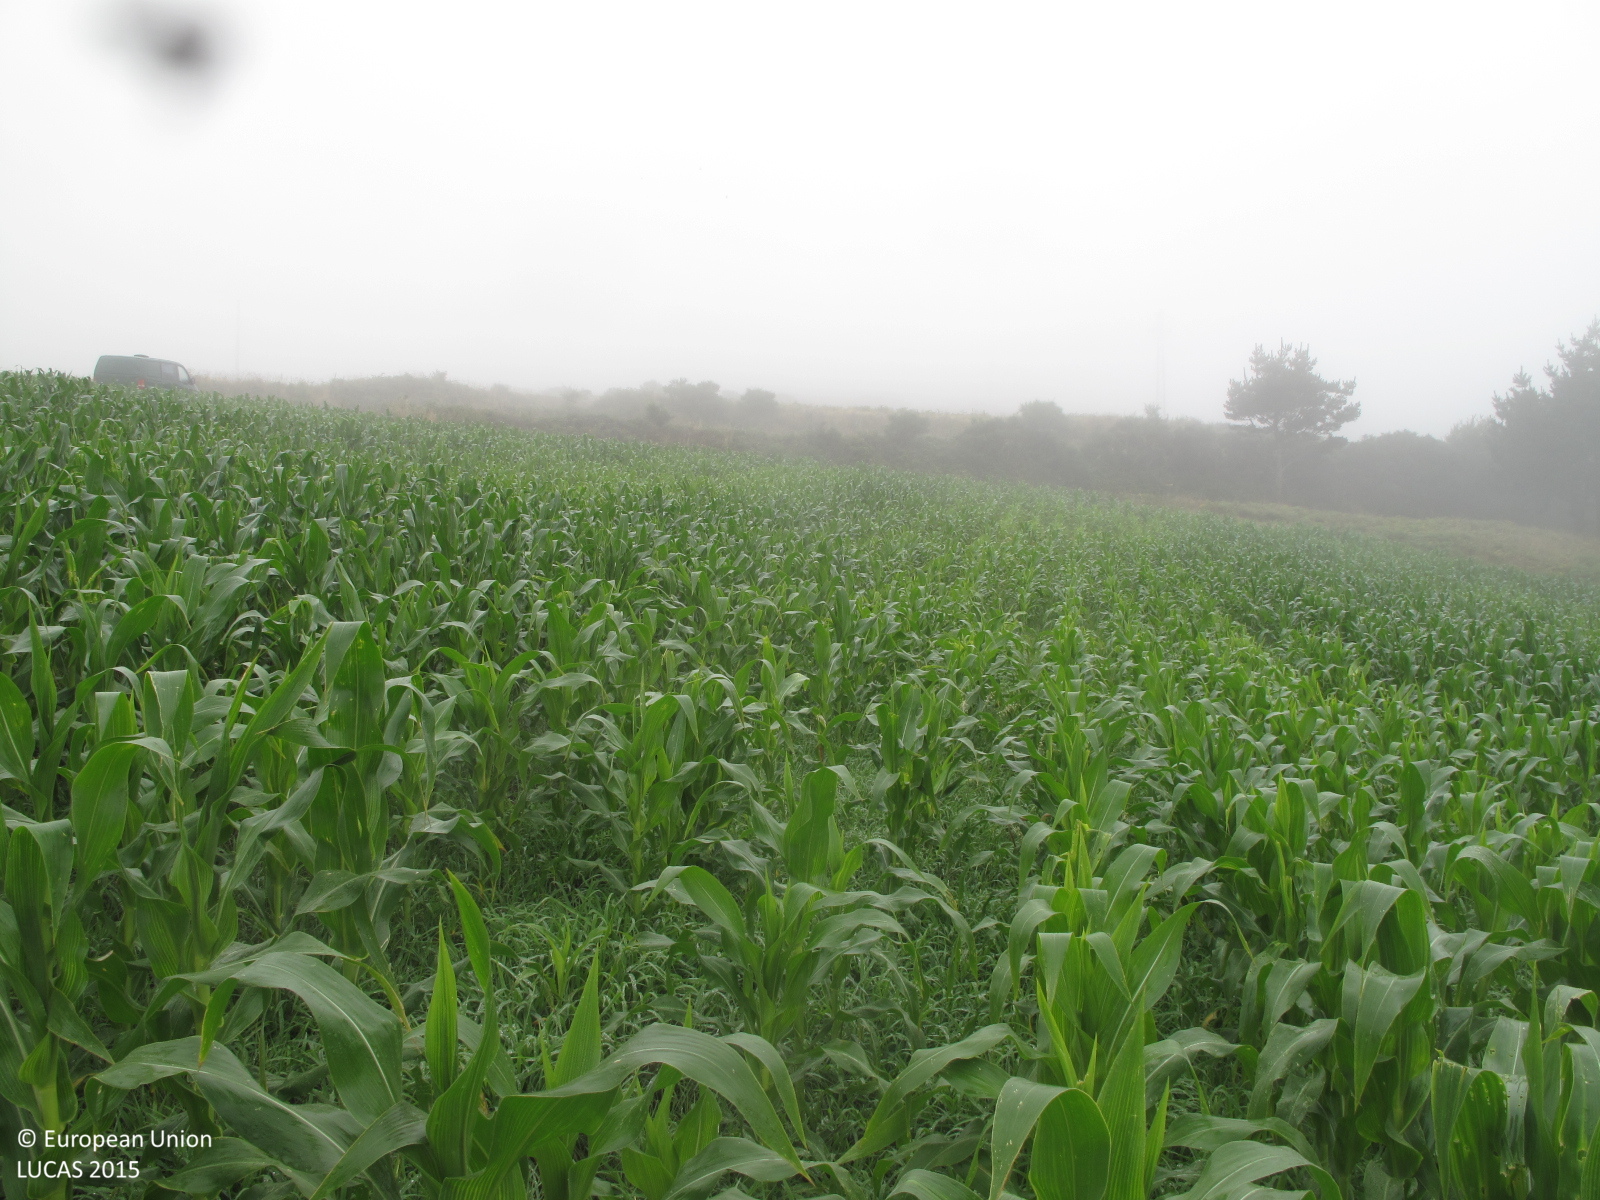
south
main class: Cropland
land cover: Maize
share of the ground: 50 - 75 %
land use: Agriculture (excluding fallow land and kitchen gardens)
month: July
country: ES
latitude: 43.0417
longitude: -9.2675
